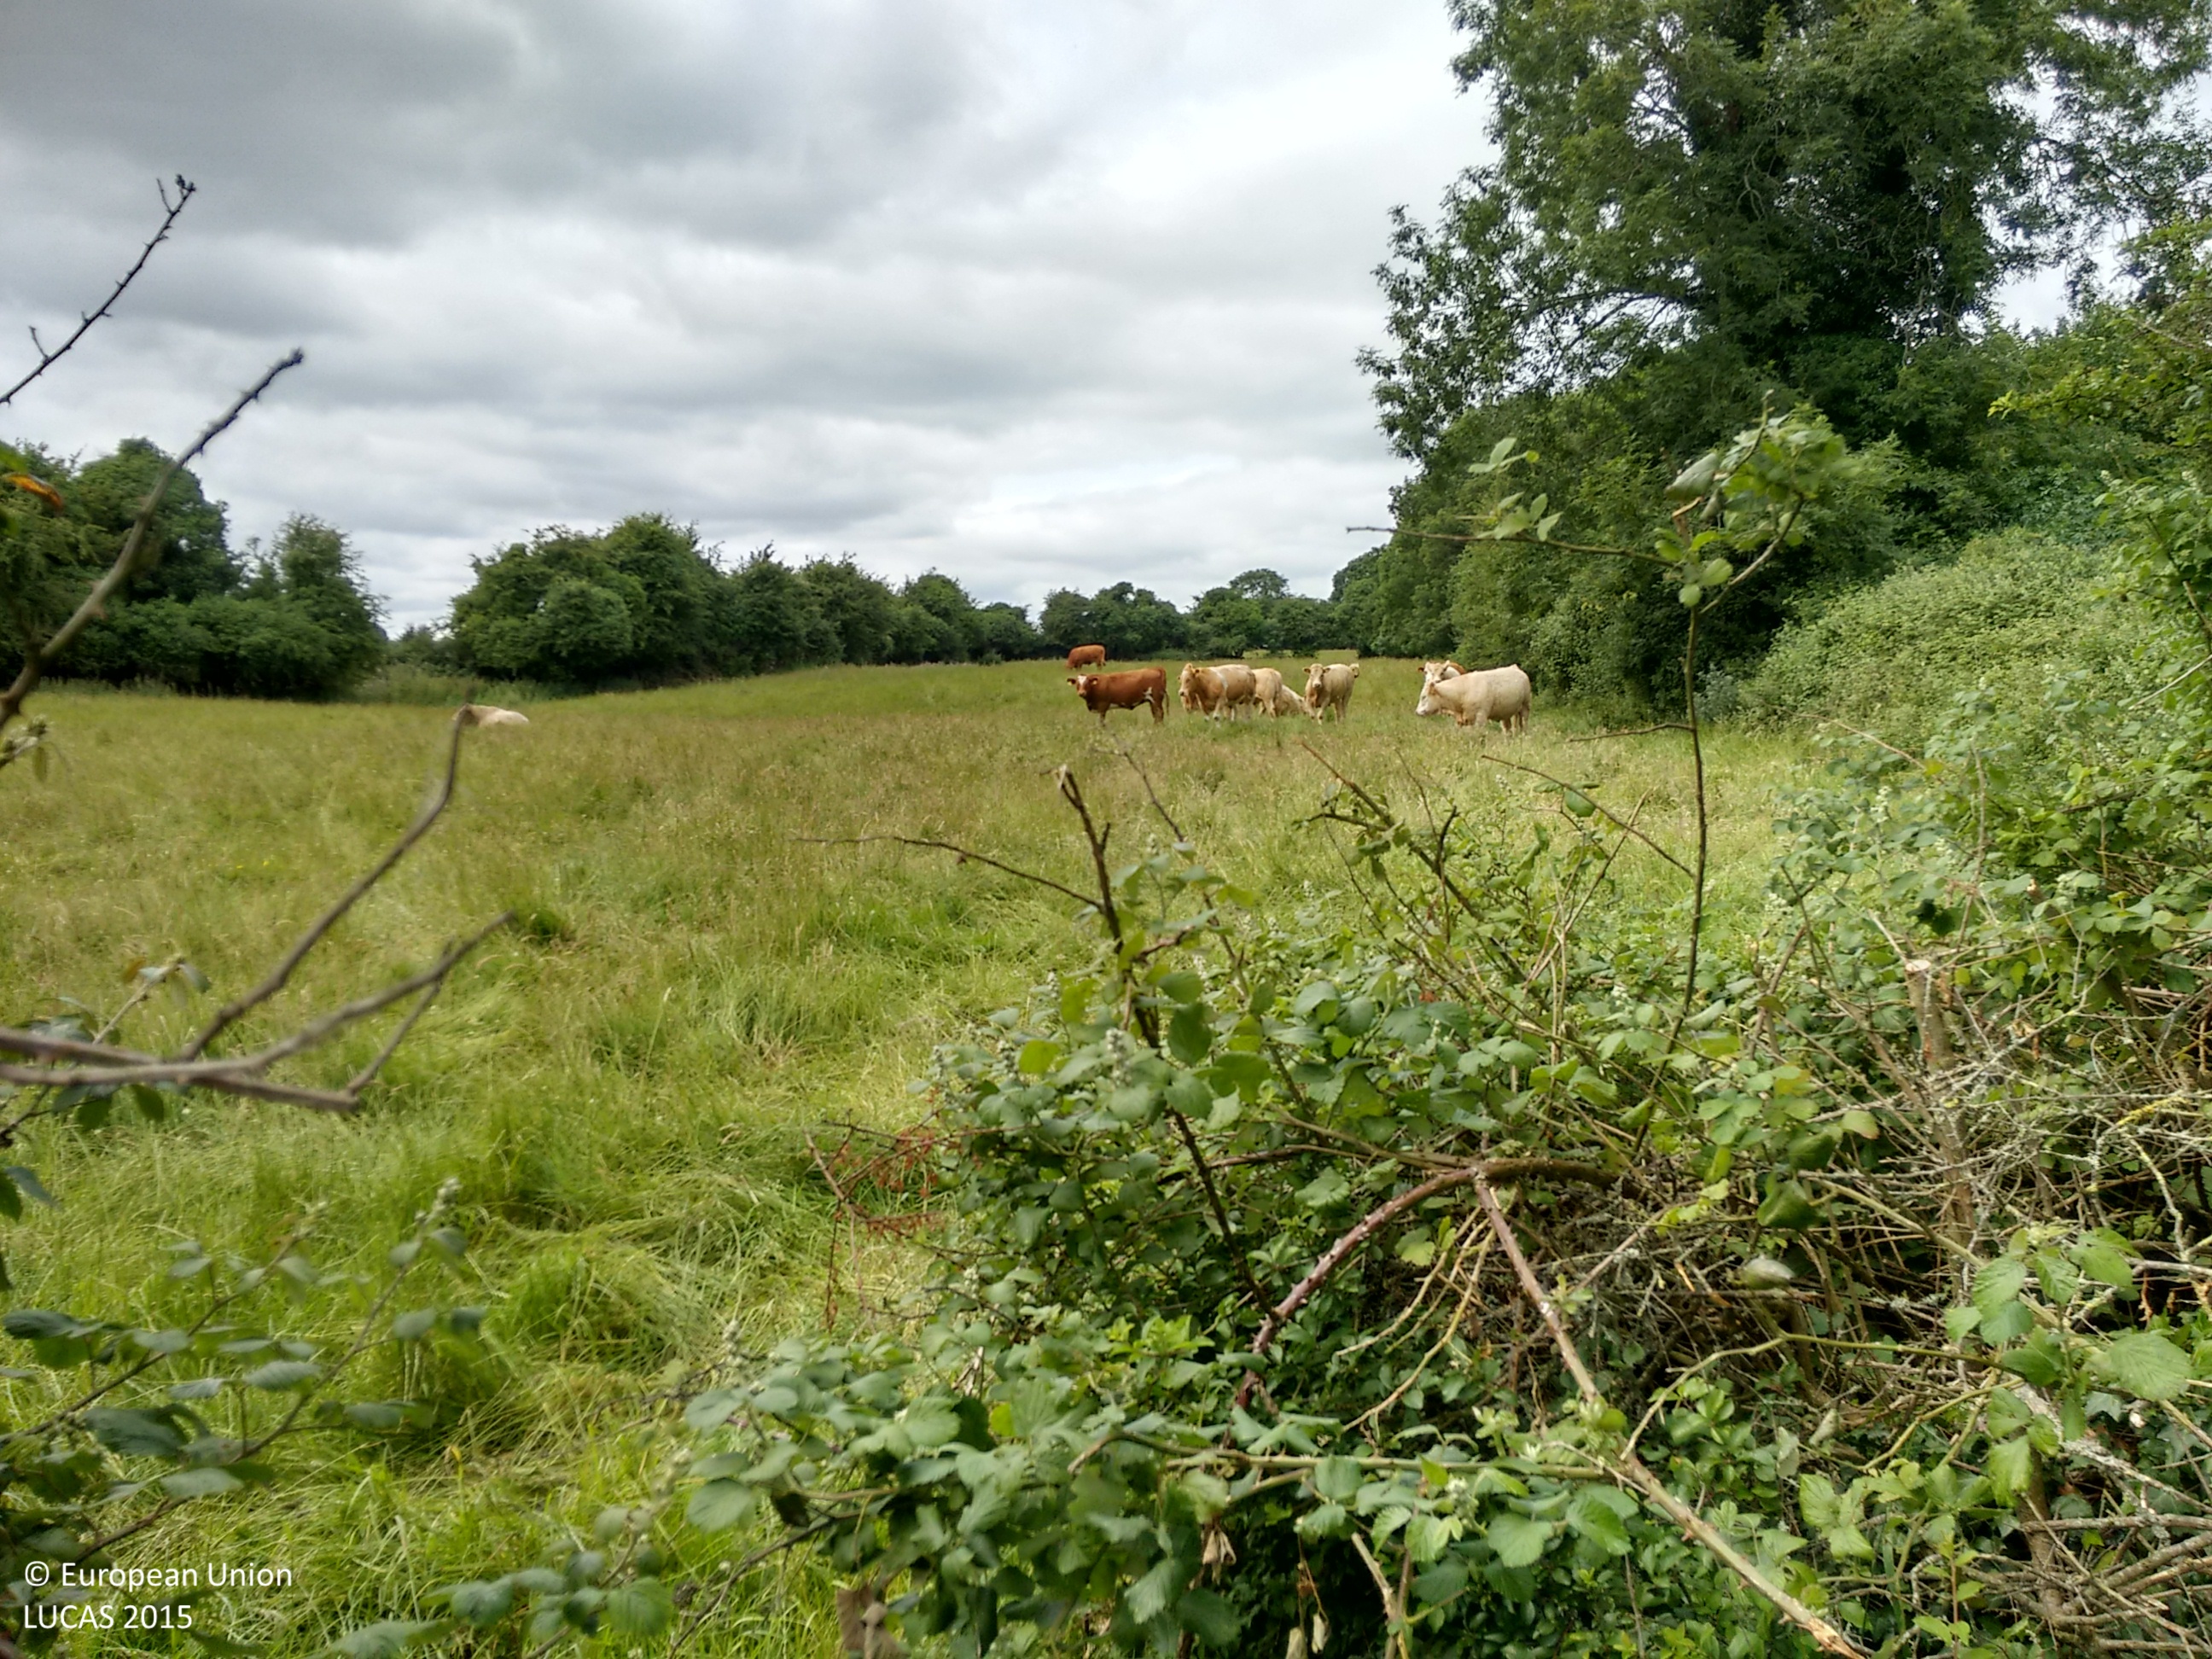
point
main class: Grassland
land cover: Grassland without tree/shrub cover
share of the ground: > 75 %
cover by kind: herbaceous plants 100 %
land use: Agriculture (excluding fallow land and kitchen gardens)
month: July
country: IE
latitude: 53.5497
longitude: -8.0000
